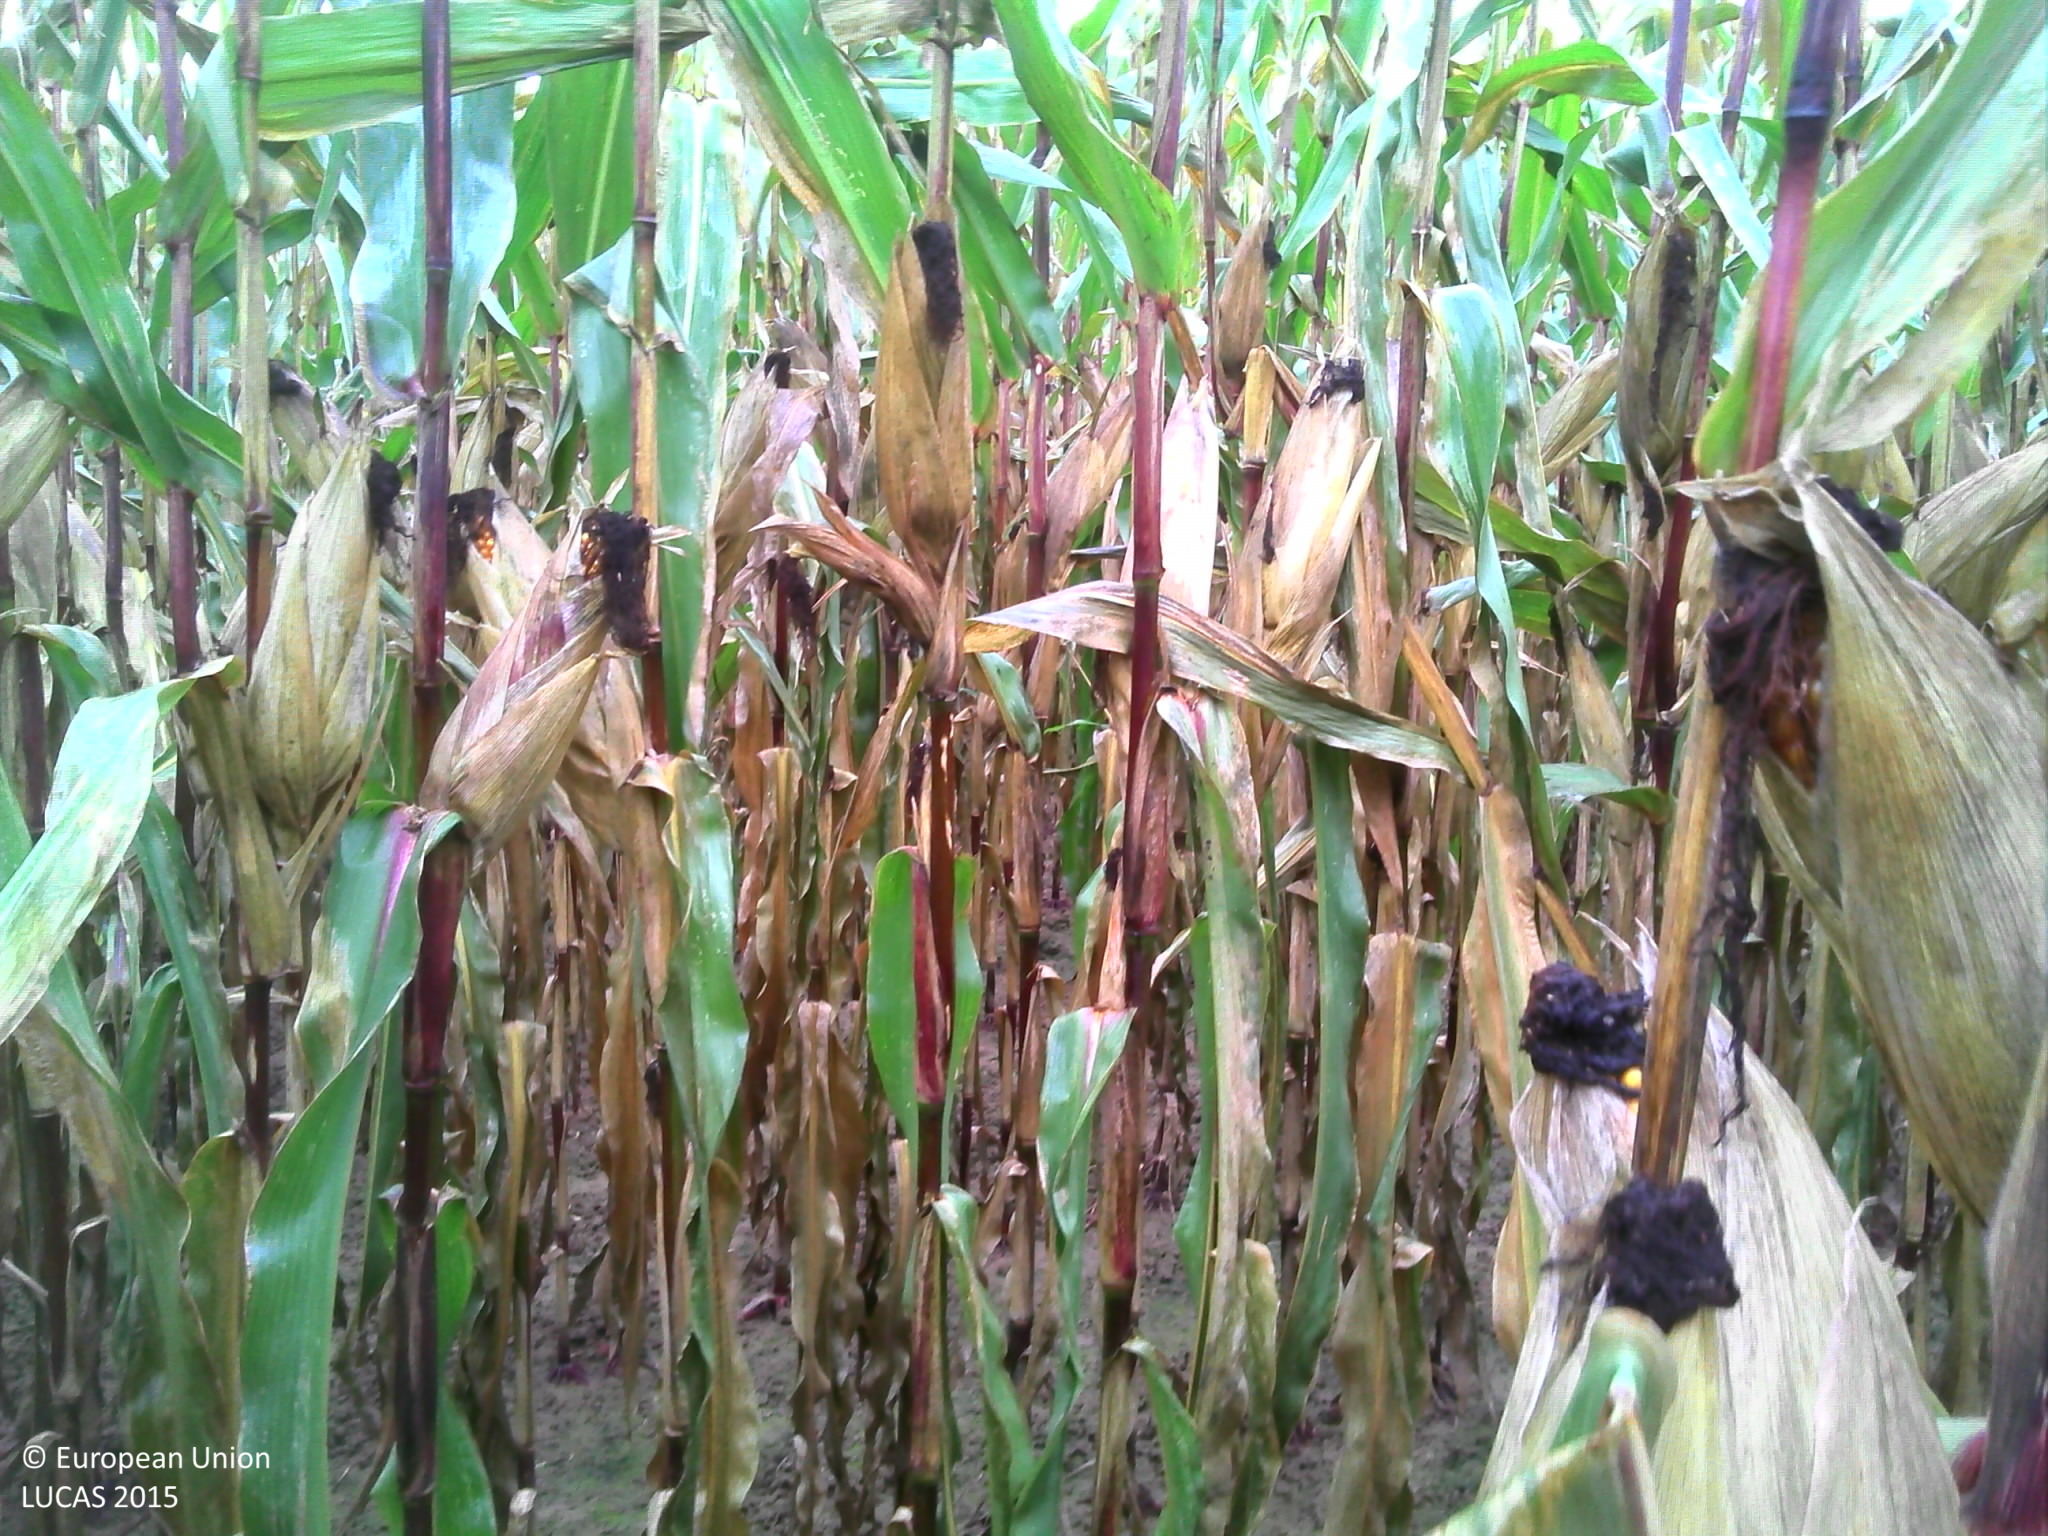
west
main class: Cropland
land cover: Maize
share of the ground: > 75 %
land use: Agriculture (excluding fallow land and kitchen gardens)
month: October
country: BE
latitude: 50.7706
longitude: 4.8495
